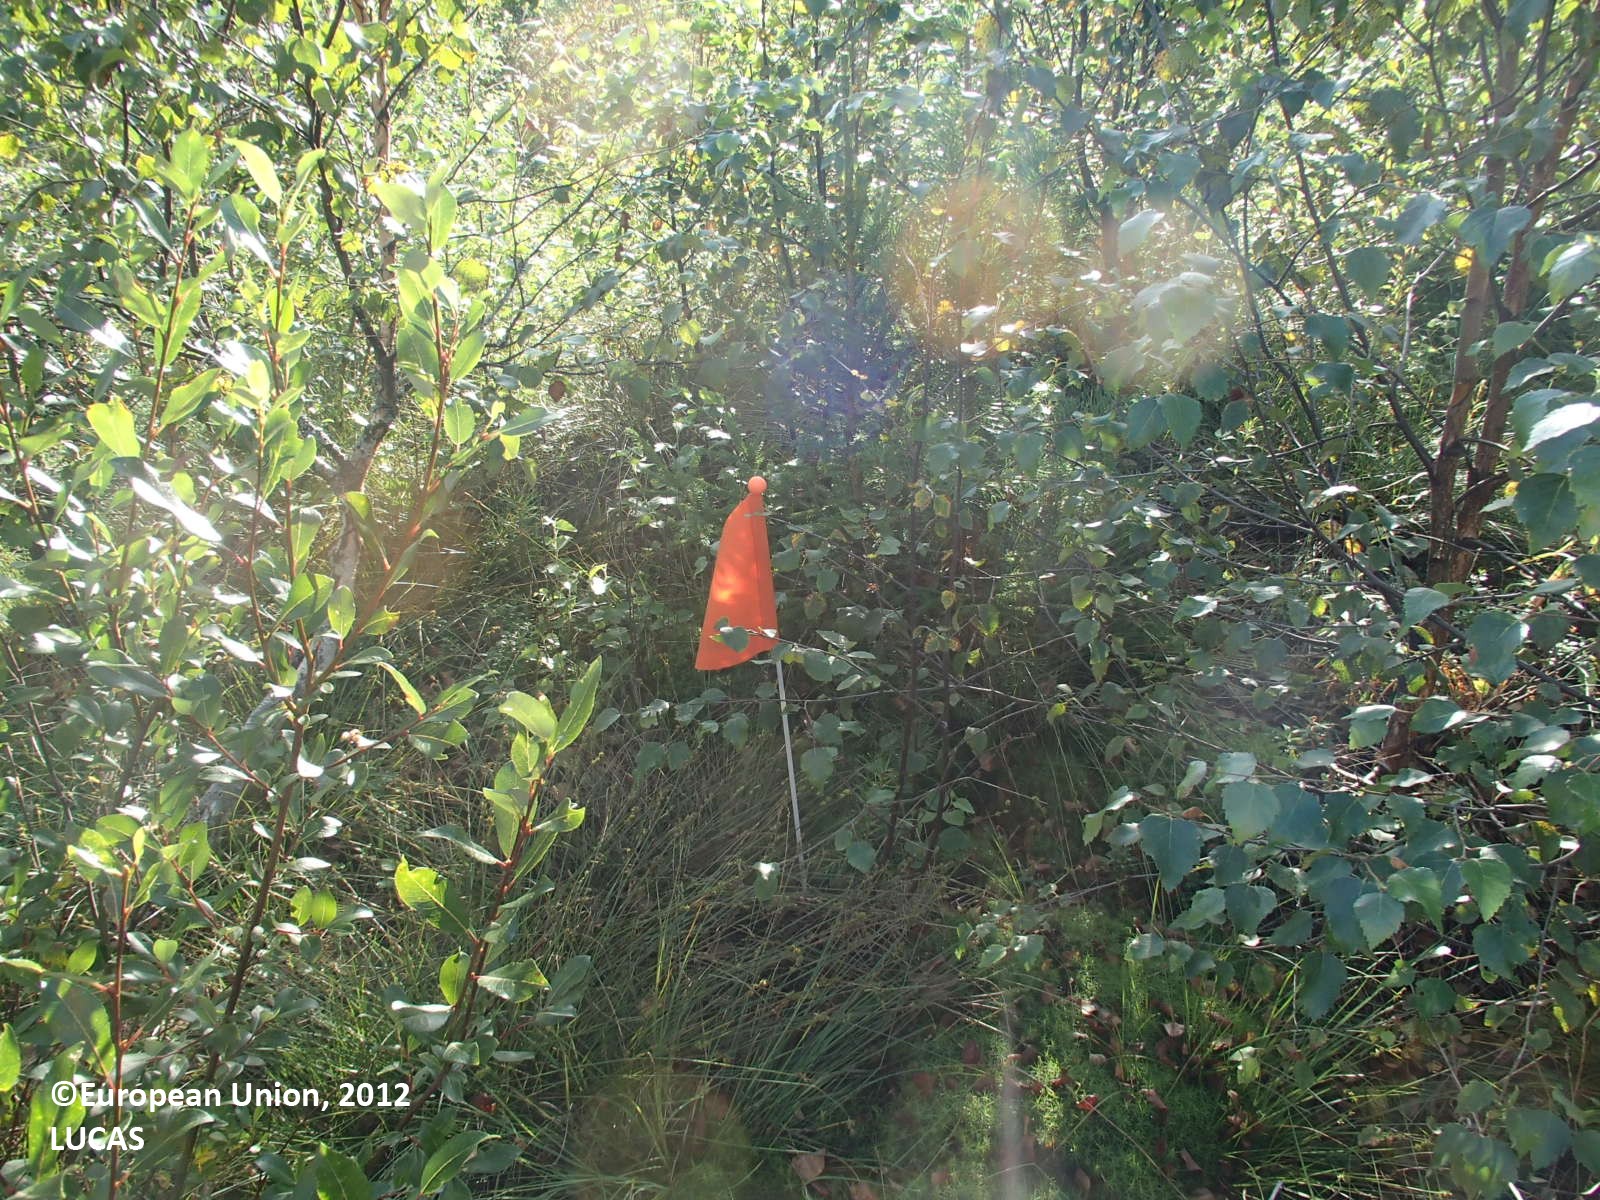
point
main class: Woodland
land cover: Other mixed woodland
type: boreal forest
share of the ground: > 75 %
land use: Forestry
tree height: < 5 m
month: August
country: FI
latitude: 63.8130
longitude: 28.0636
